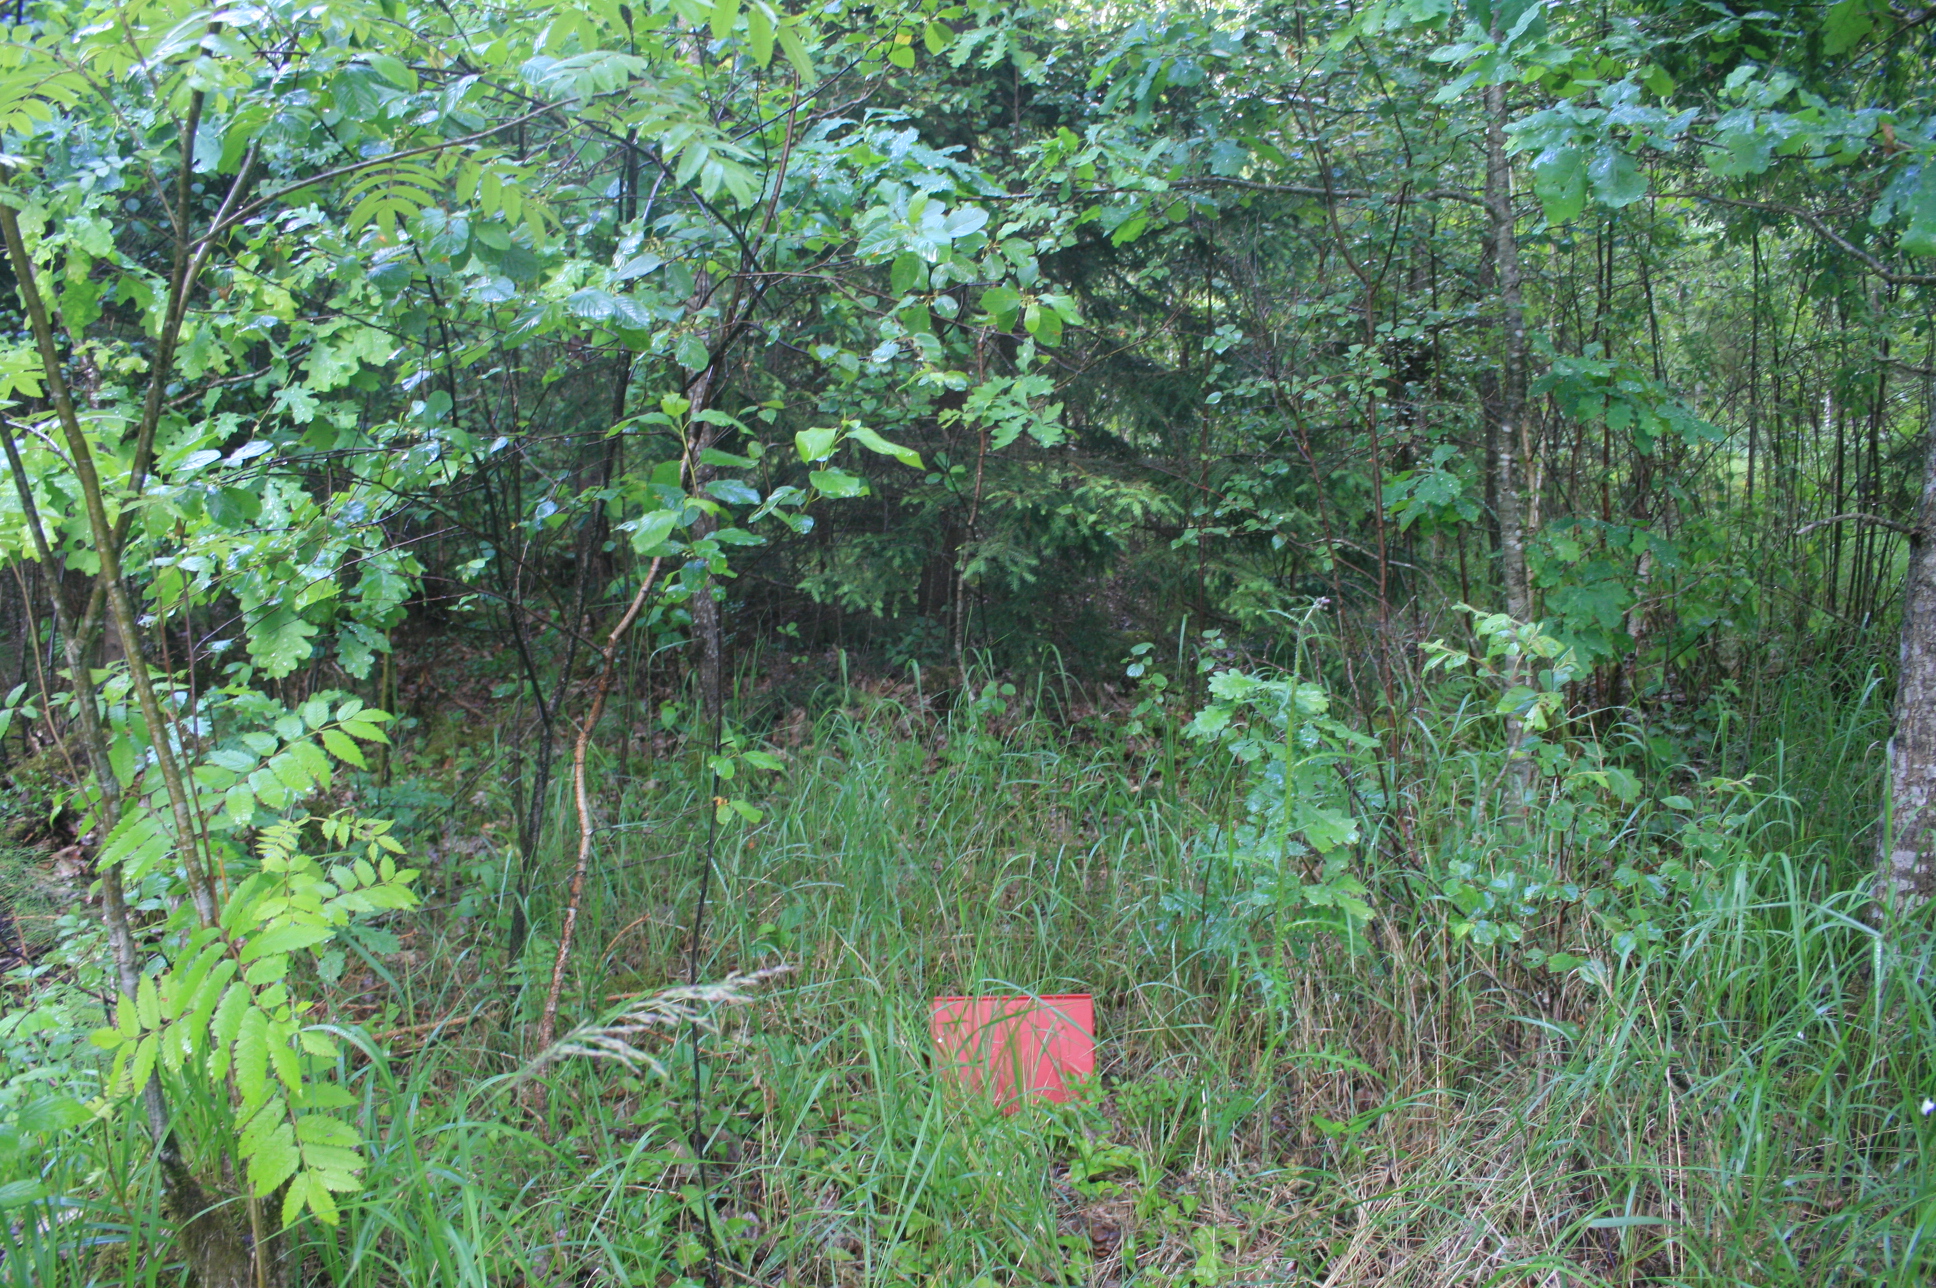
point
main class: Woodland
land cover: Spruce dominated mixed woodland
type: hemiboreal forest and nemoral coniferous forest and mixed broadleaved-coniferous forest
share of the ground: > 75 %
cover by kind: coniferous forest trees 45 %, broadleaved forest trees 35 %, herbaceous plants 20 %
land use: Forestry
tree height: > 5 m
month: June
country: LT
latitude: 55.3557
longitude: 22.1217
